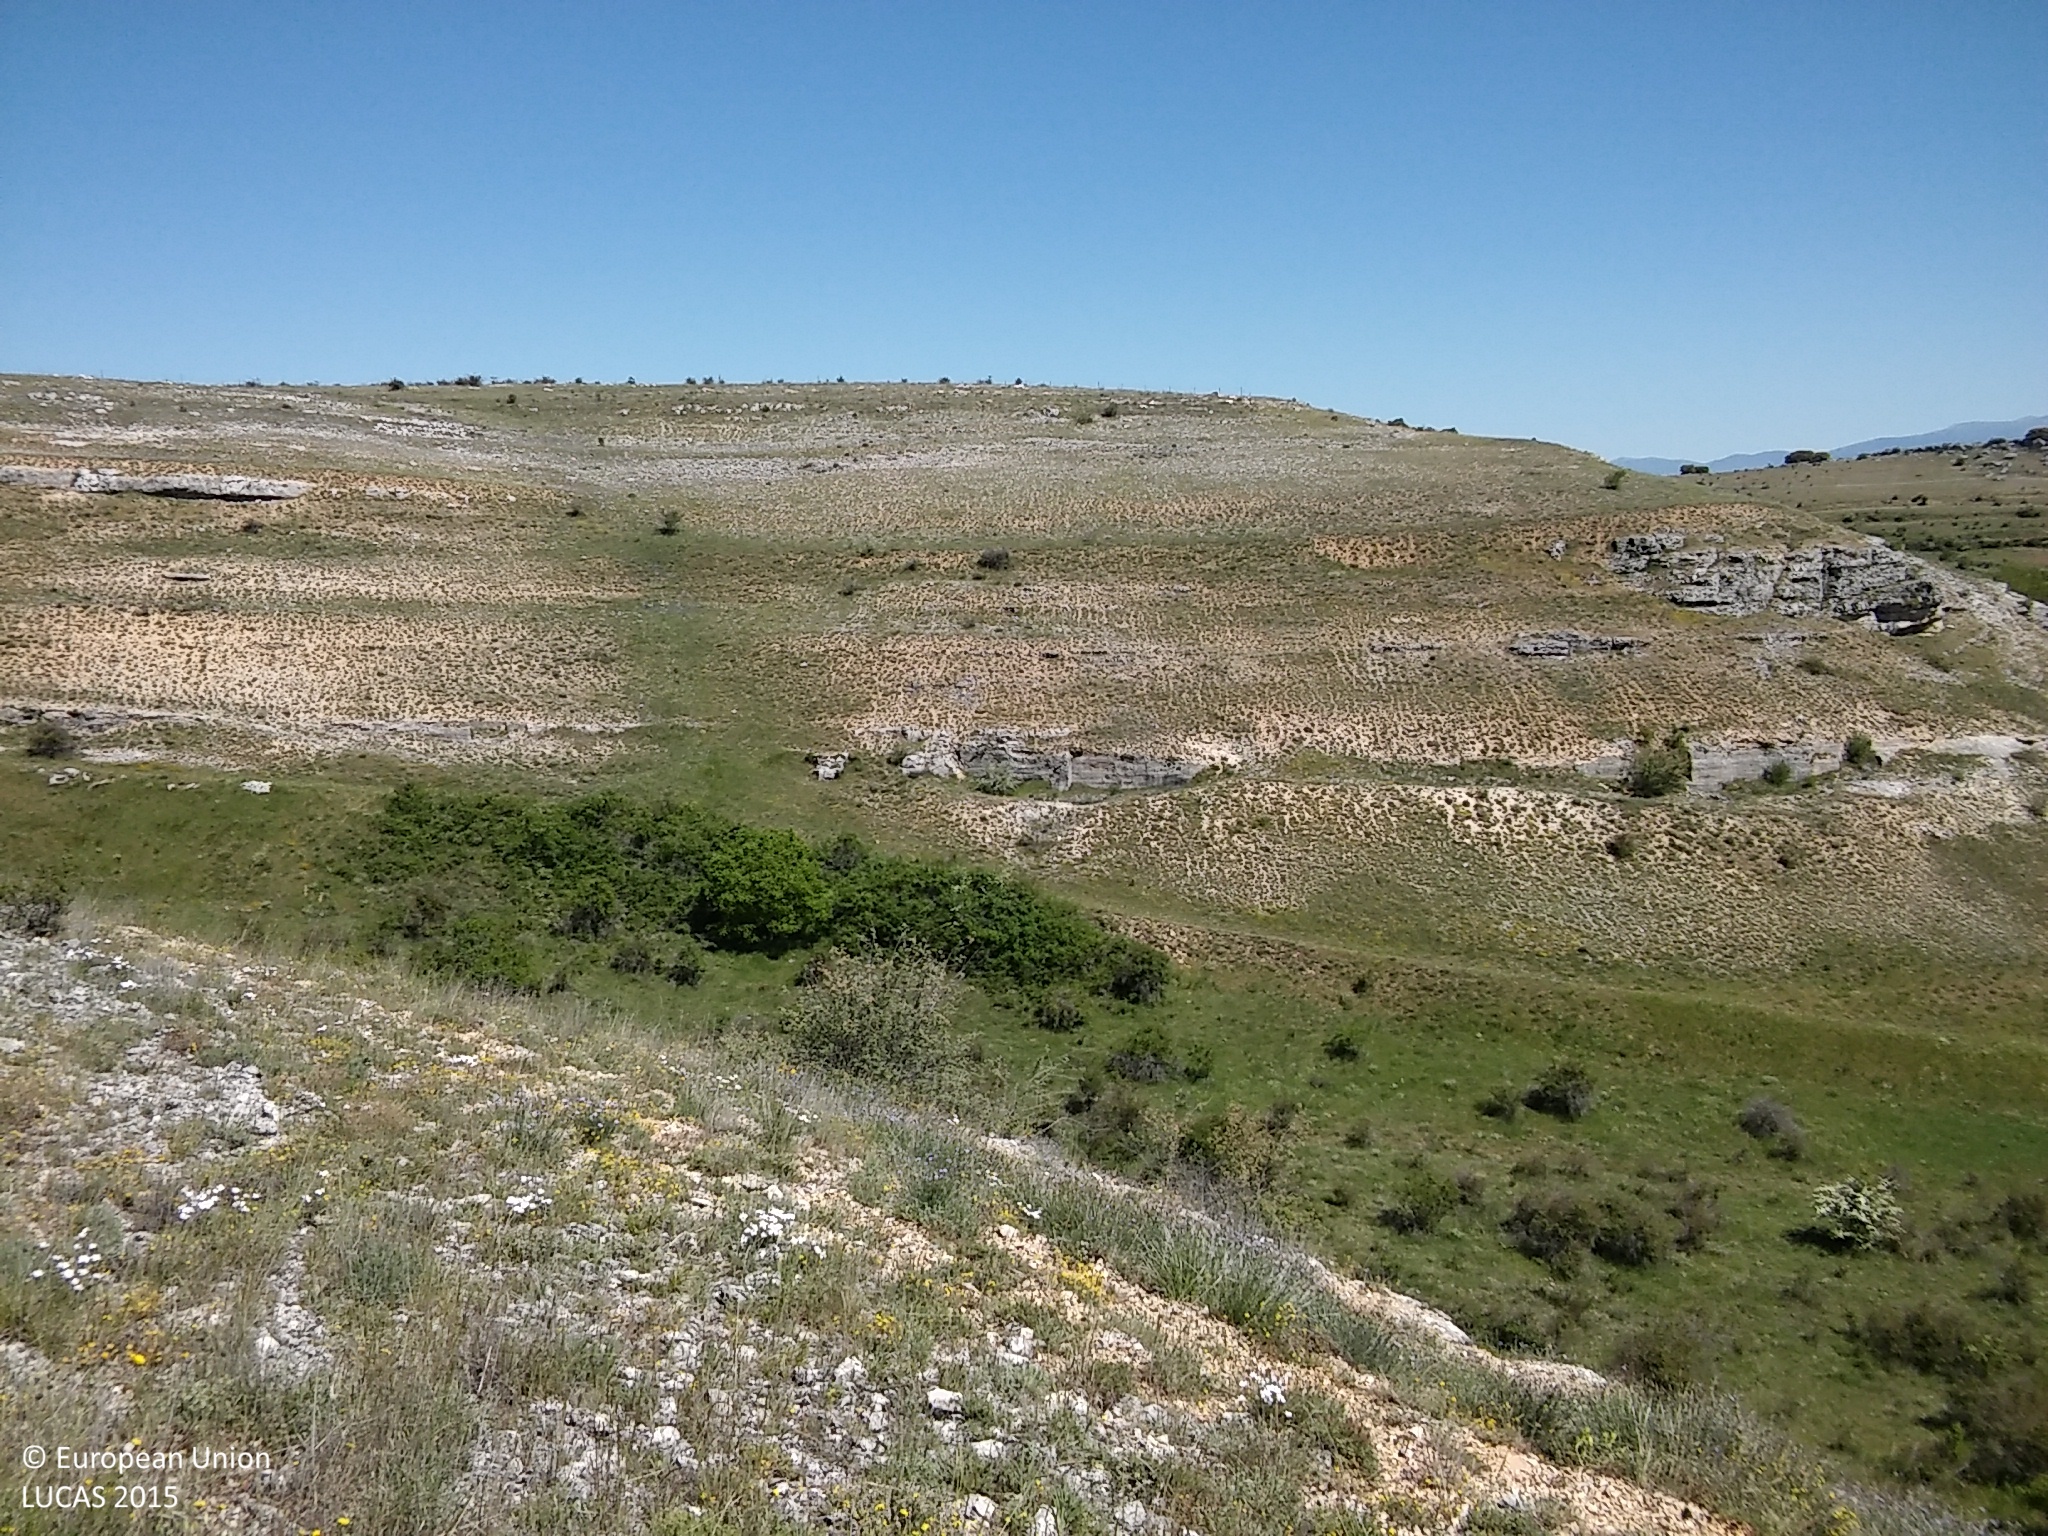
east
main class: Shrubland
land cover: Shrubland without tree cover
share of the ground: 25 - 50 %
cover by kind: shrubs 40 %, unconsolidated bare surface 35 %, consolidated bare surface 15 %, herbaceous plants 10 %
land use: Agriculture (excluding fallow land and kitchen gardens)
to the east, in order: Shrubland without tree cover; Shrubland with sparse tree cover; Shrubland without tree cover; Fences; Spontaneously vegetated surfaces
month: May
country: ES
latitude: 41.4185
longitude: -3.7500
